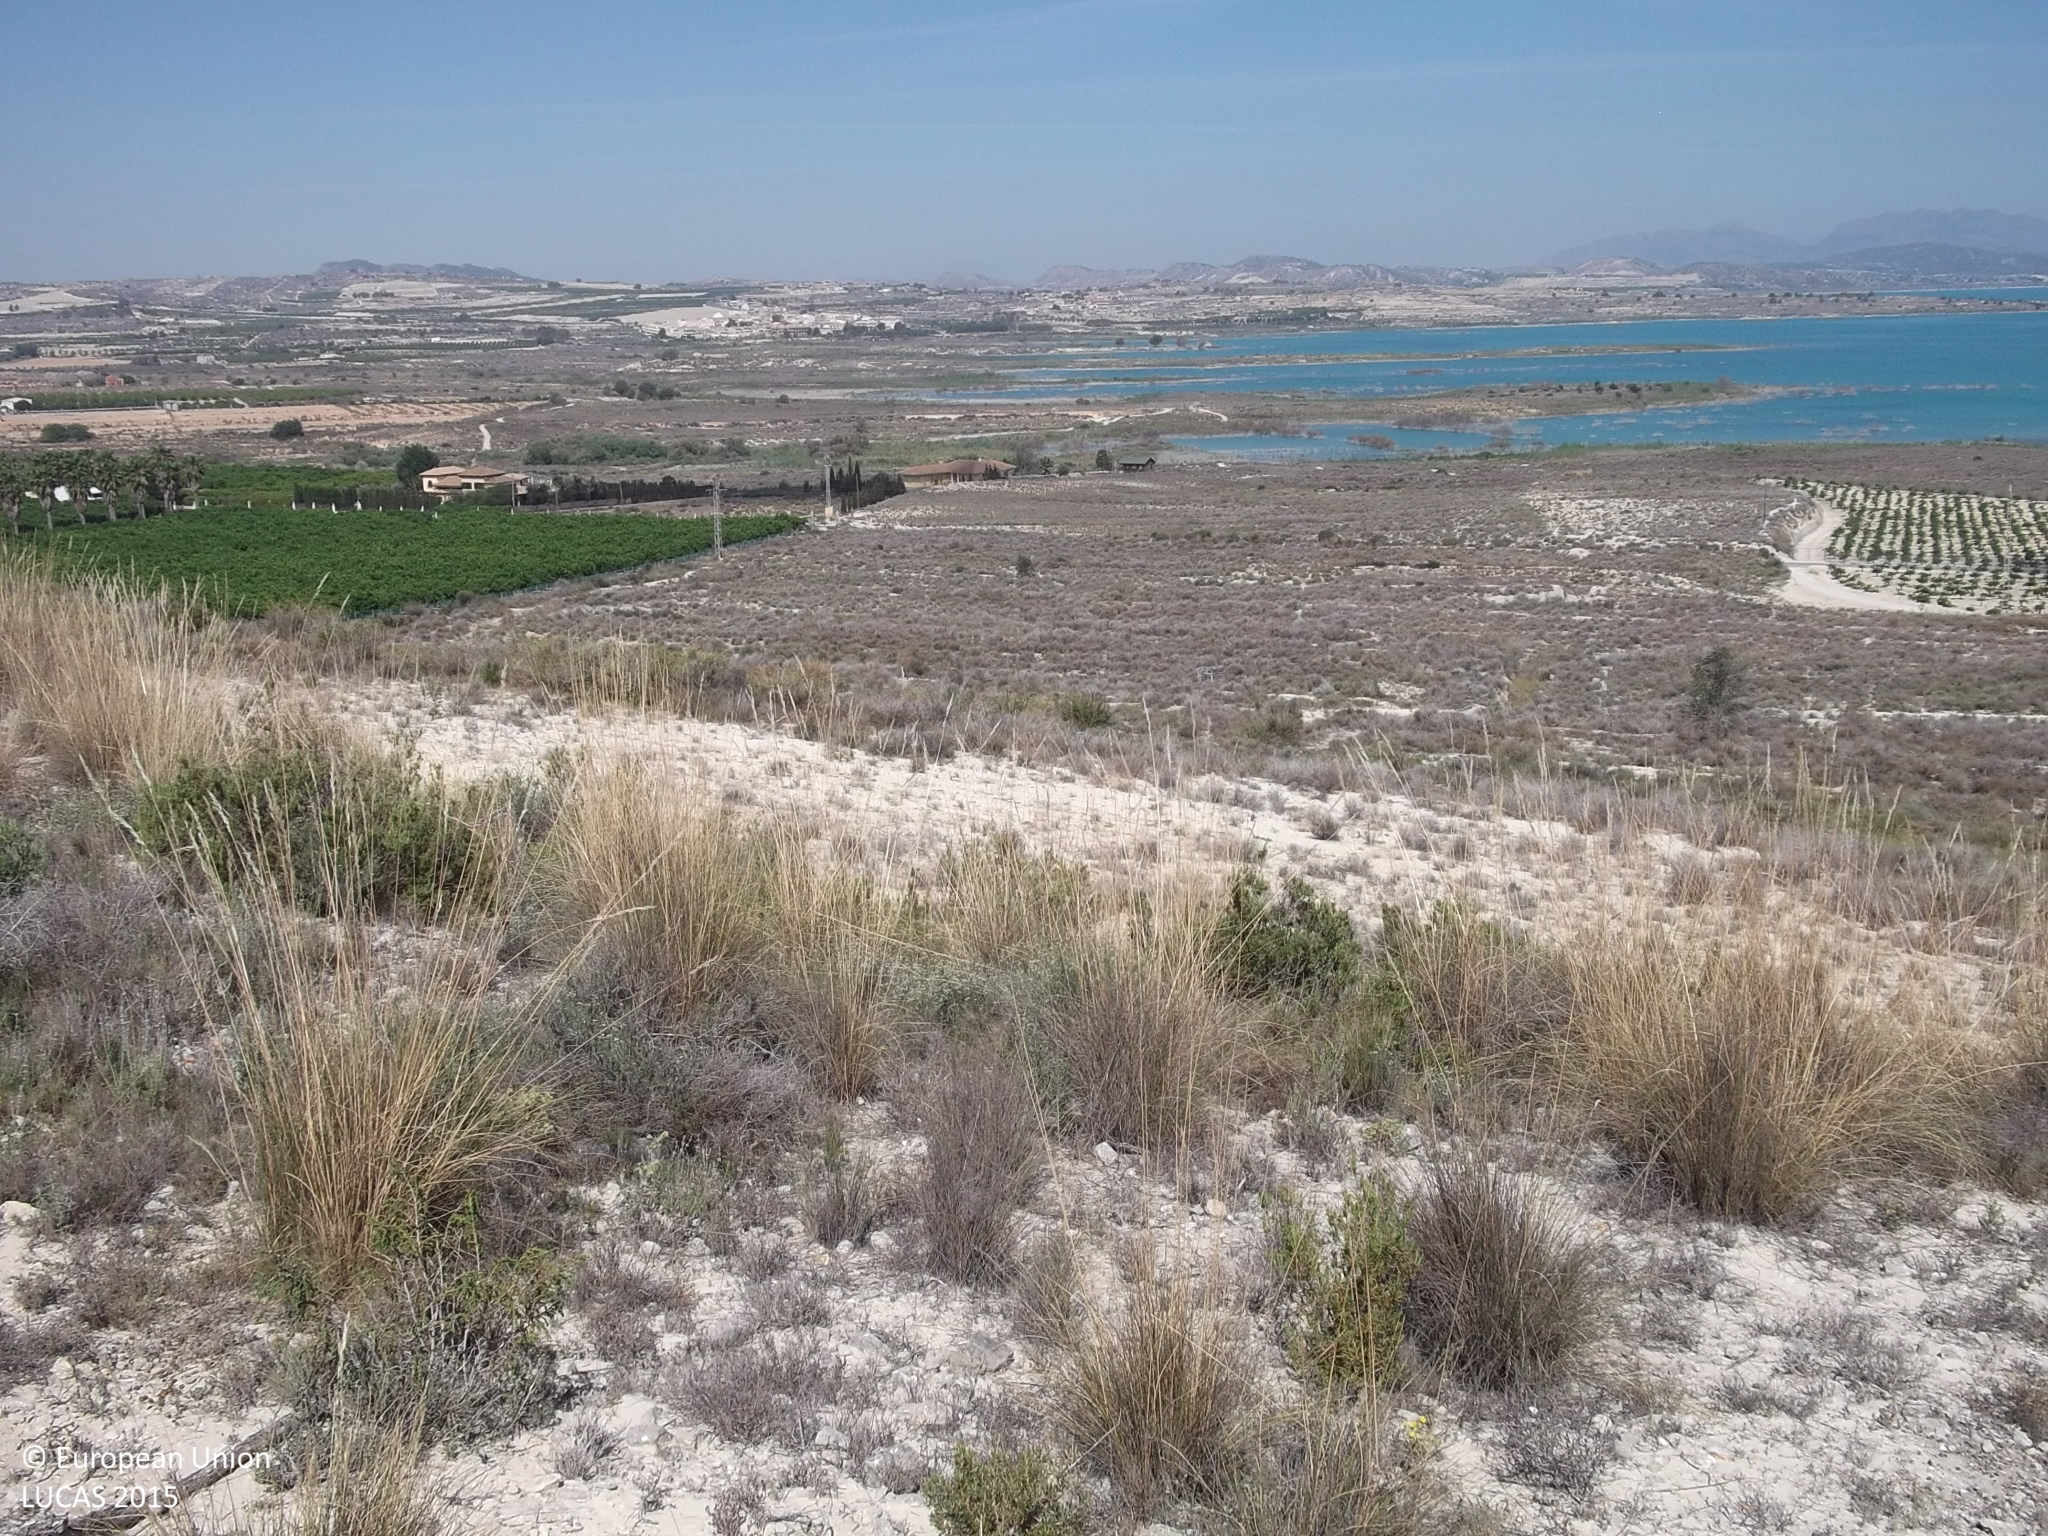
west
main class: Shrubland
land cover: Shrubland without tree cover
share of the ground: 25 - 50 %
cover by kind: shrubs 40 %, herbaceous plants 30 %, consolidated bare surface 30 %
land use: Semi-natural and natural areas not in use
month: May
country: ES
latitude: 37.9859
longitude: -0.8332
